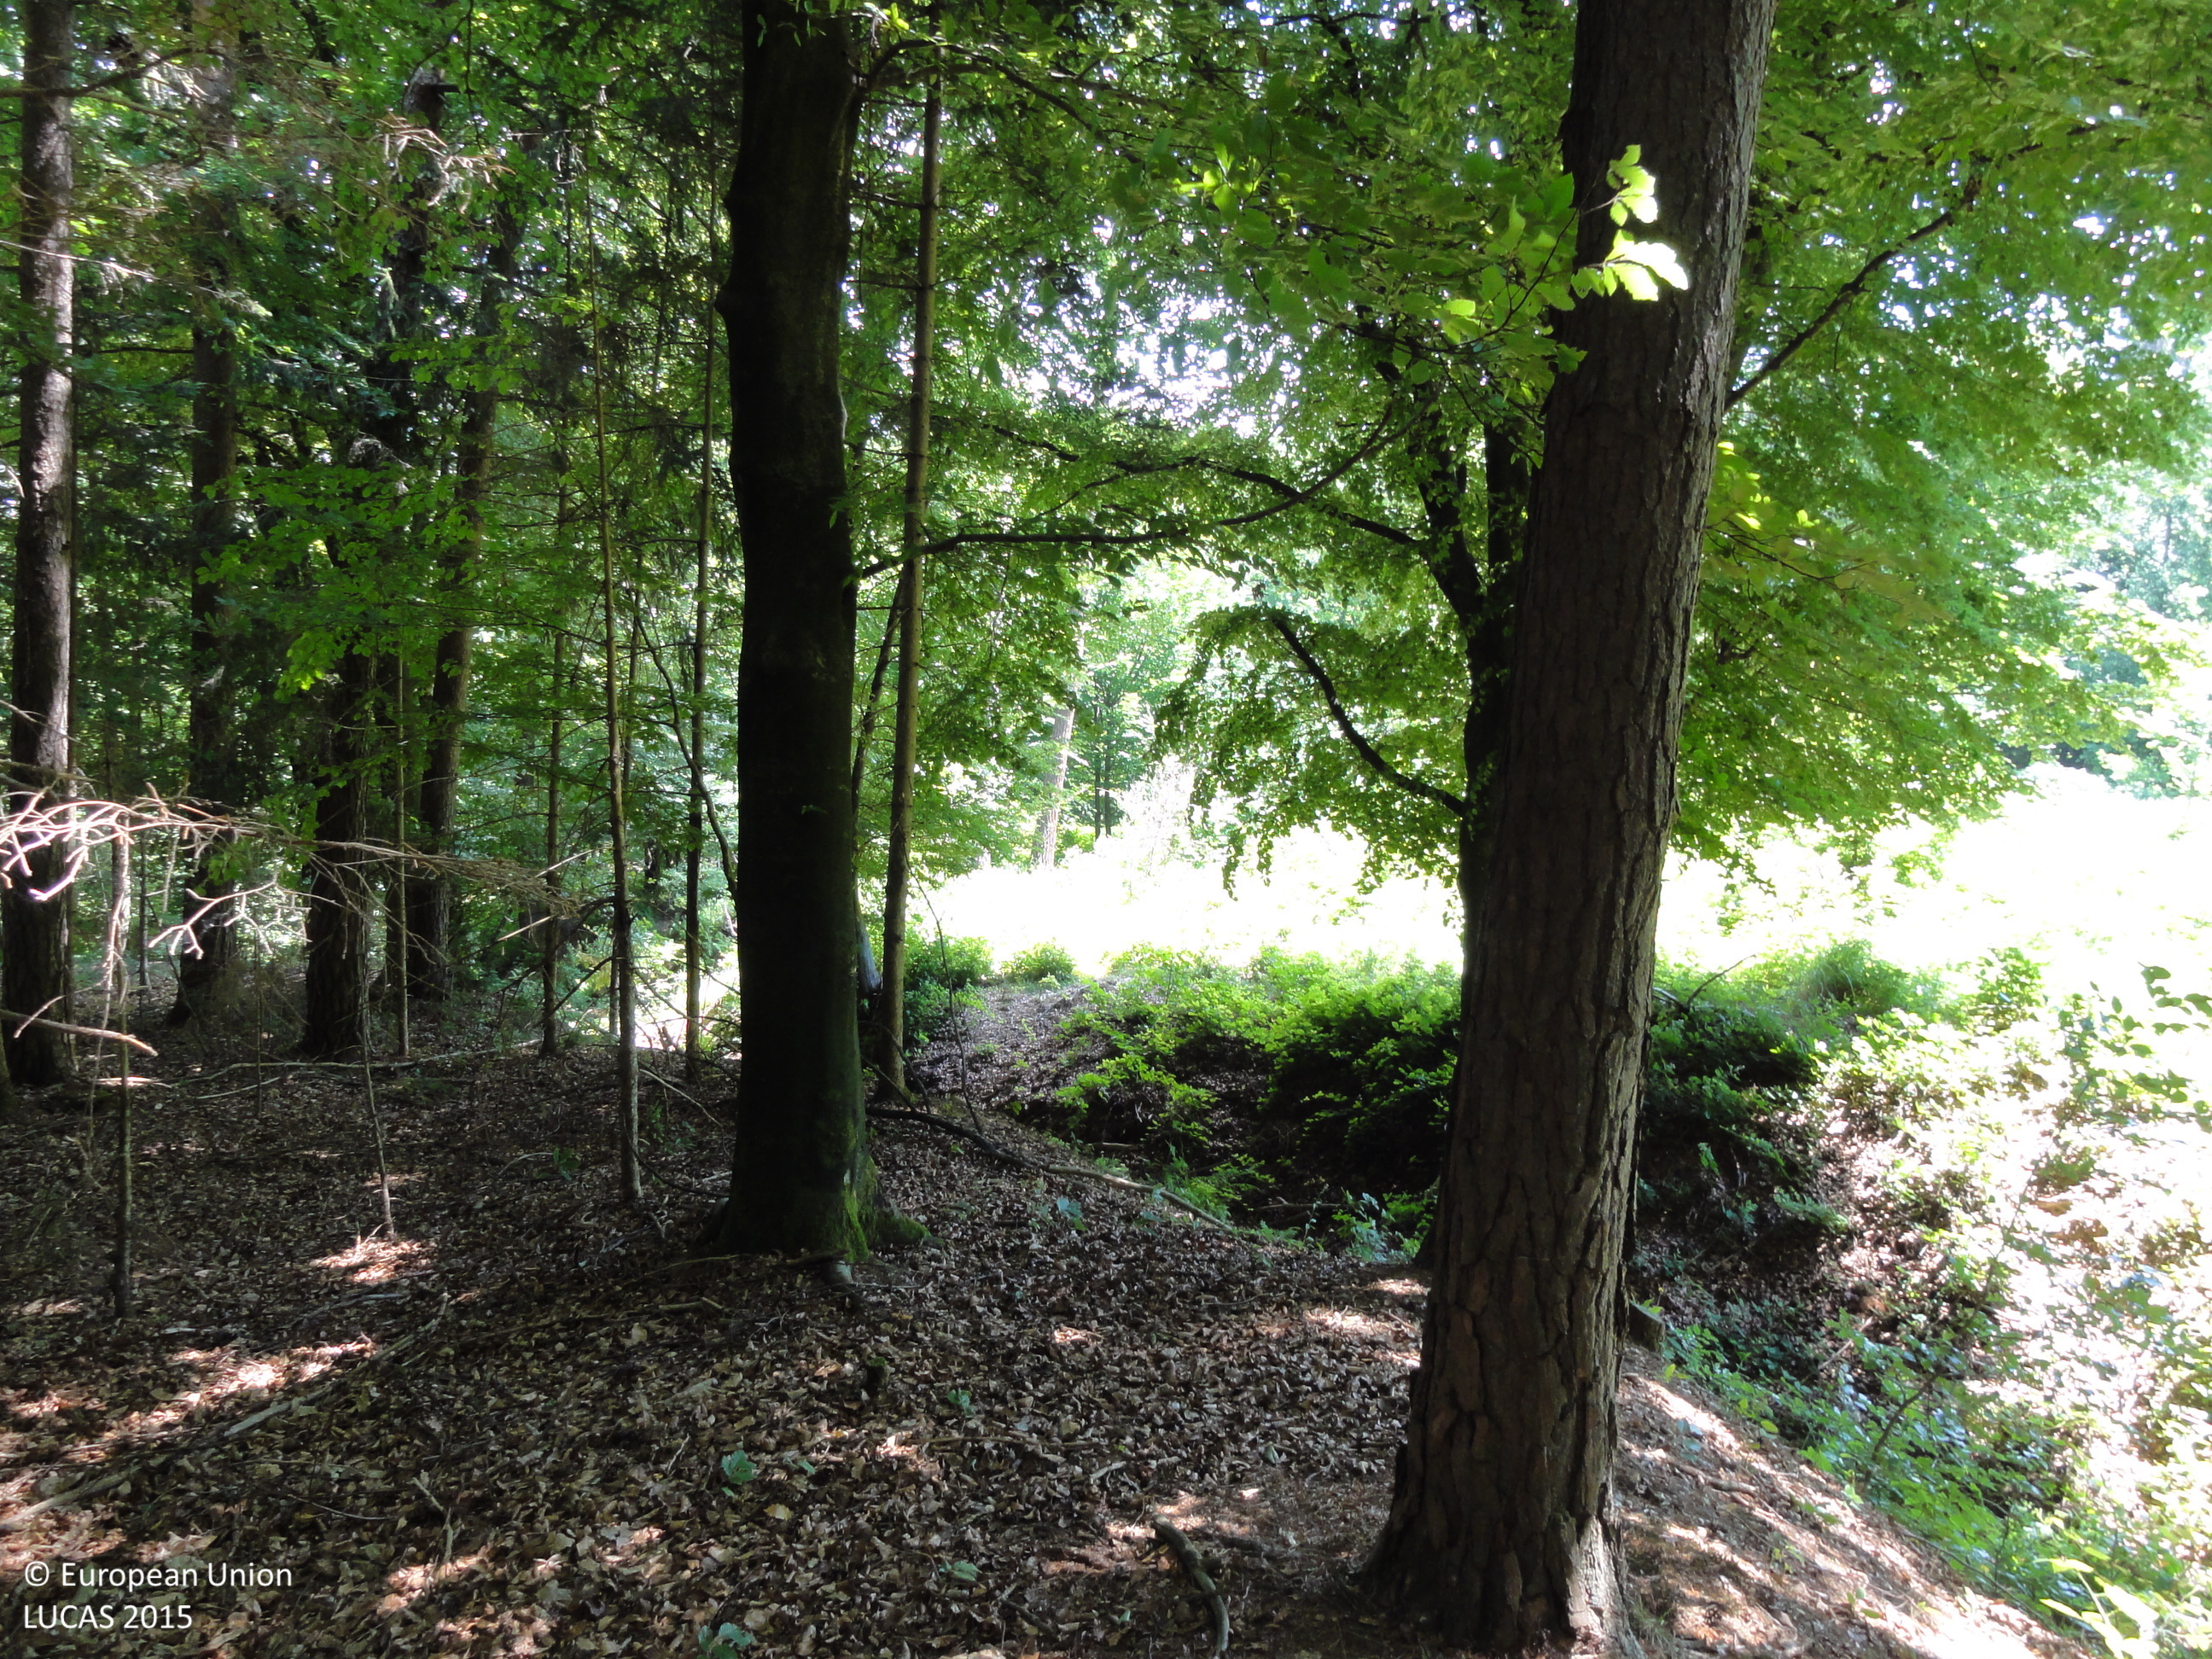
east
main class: Woodland
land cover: Other mixed woodland
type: mesophytic deciduous forest
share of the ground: > 75 %
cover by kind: coniferous forest trees 60 %, broadleaved forest trees 40 %
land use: Forestry
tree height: > 5 m
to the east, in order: Other mixed woodland; Pine dominated mixed woodland; Ditches and canals; Pine dominated mixed woodland; Spruce dominated mixed woodland; Spruce dominated coniferous woodland; Ditches and canals; Spruce dominated coniferous woodland; Pine dominated mixed woodland; Tracks; Pine dominated mixed woodland; Tracks; Other mixed woodland
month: June
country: SI
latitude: 46.8573
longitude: 16.2052
